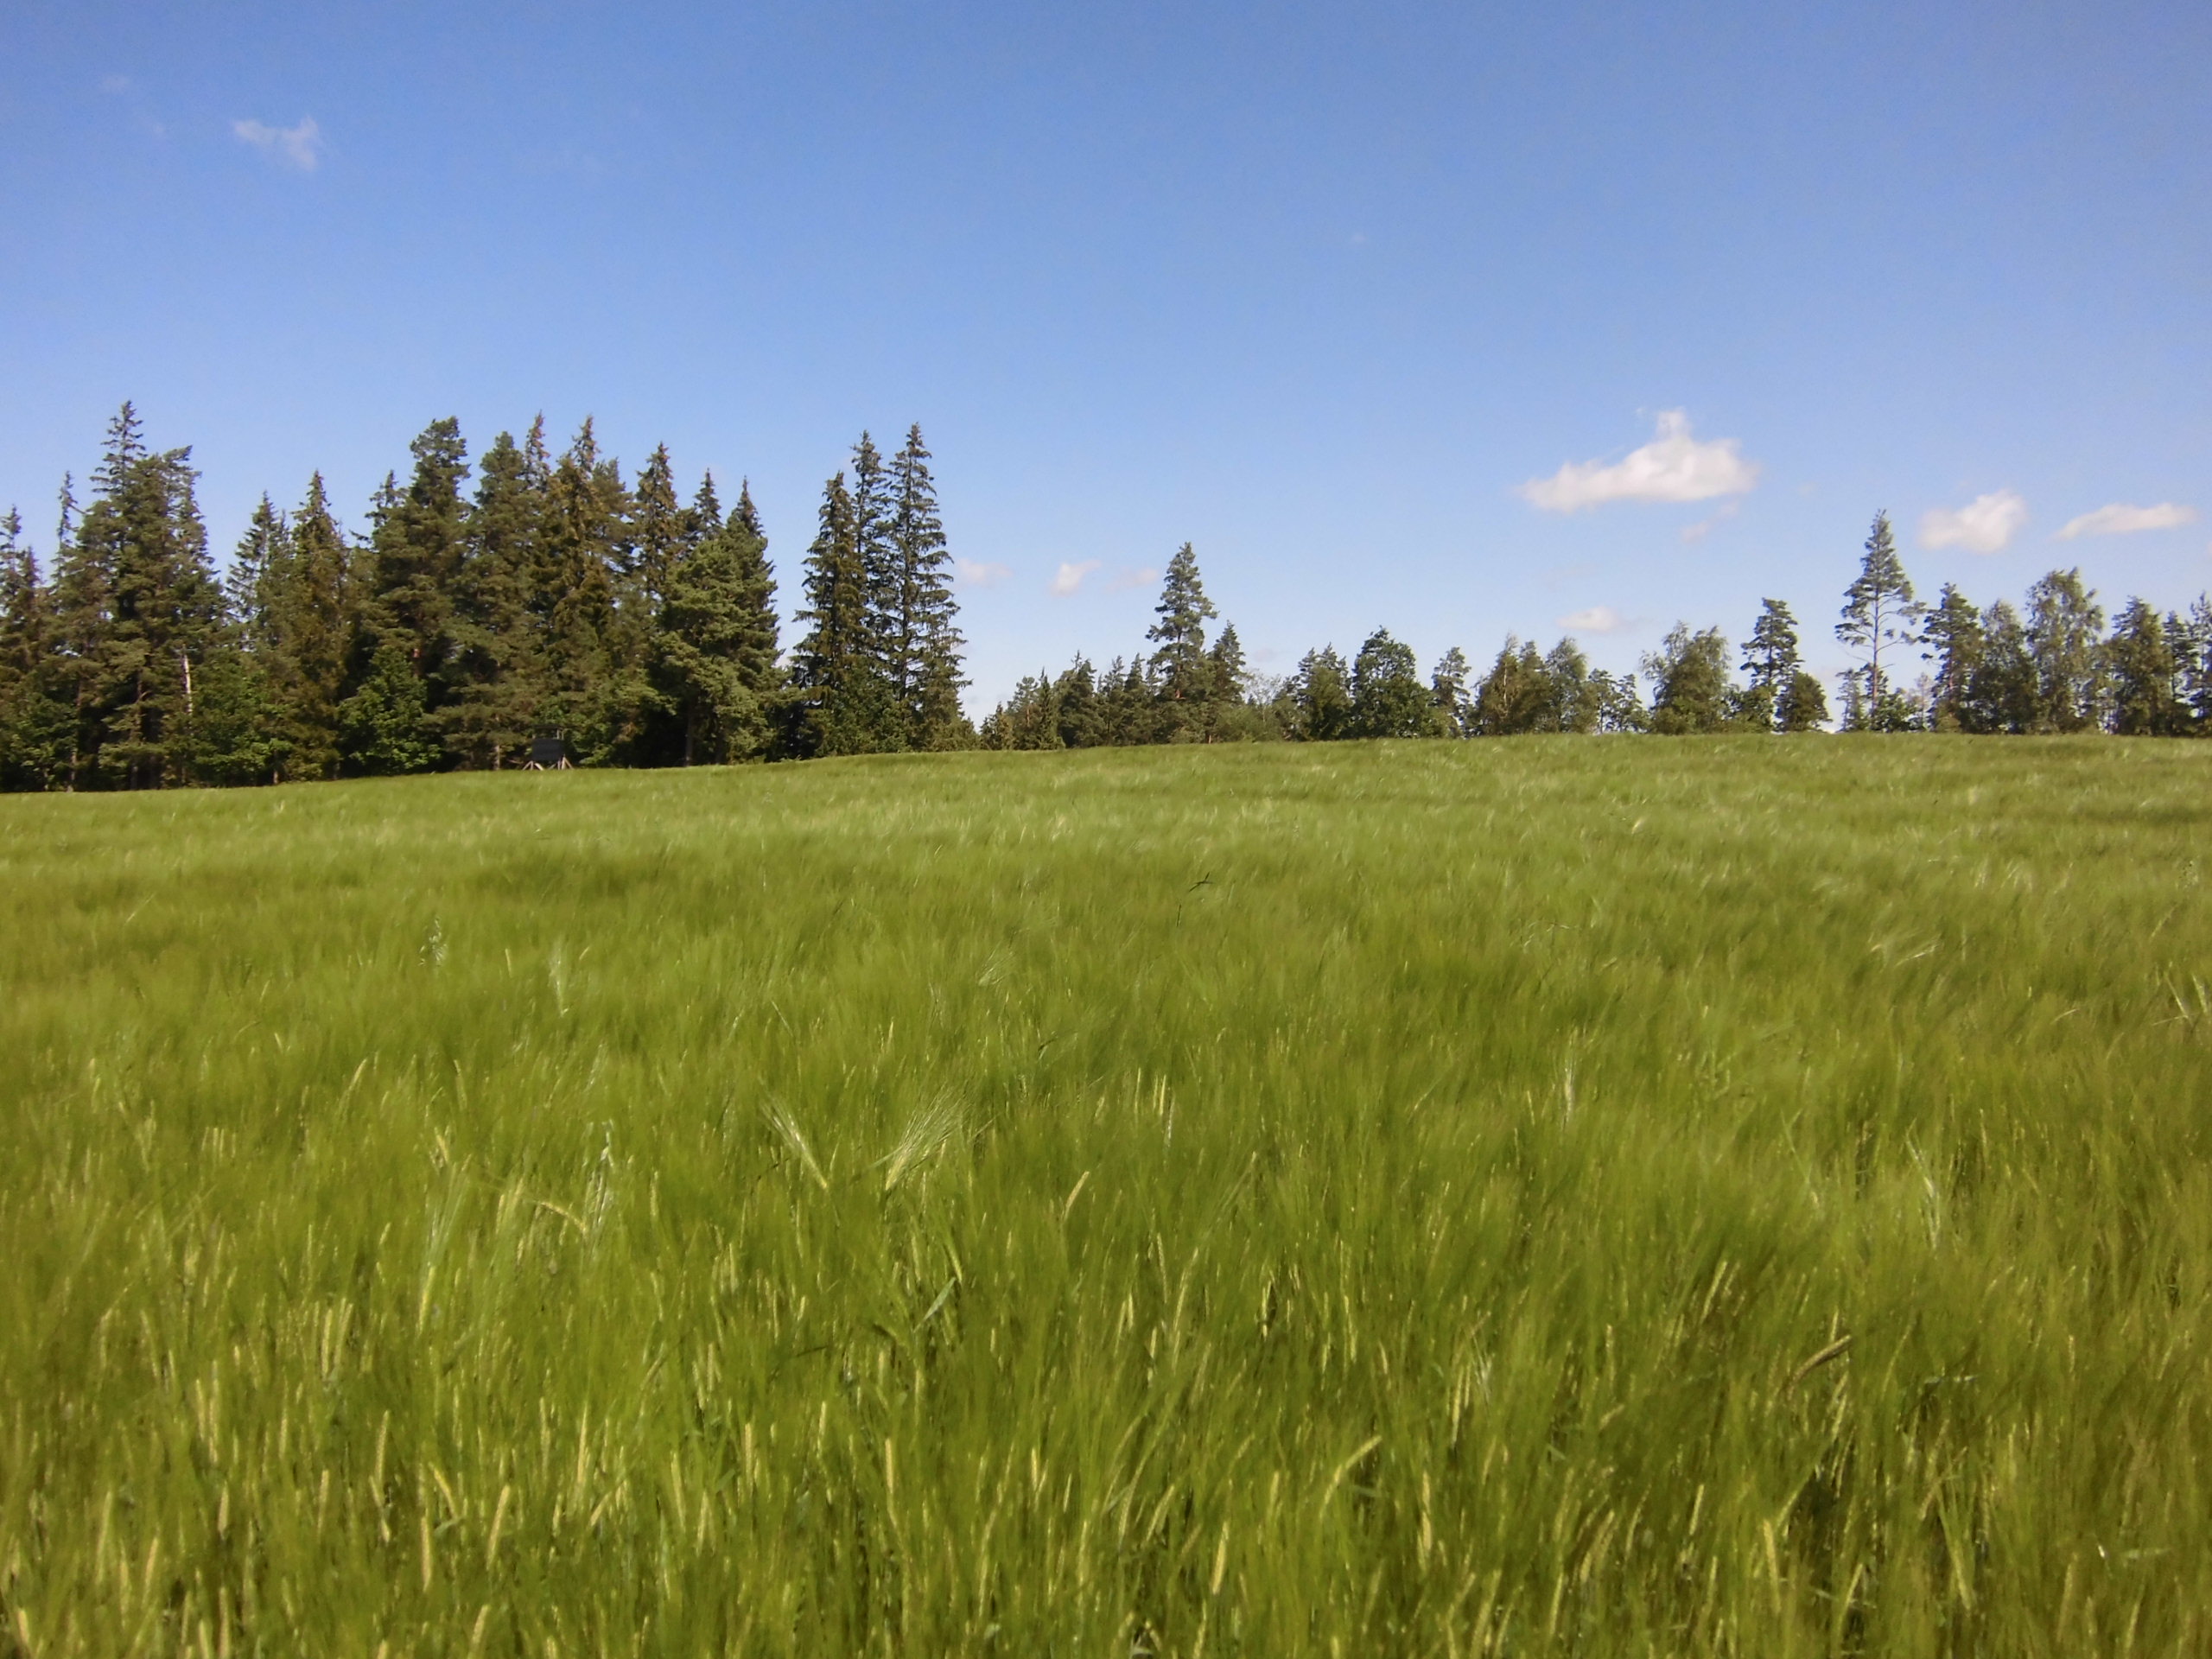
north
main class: Cropland
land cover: Barley
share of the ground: > 75 %
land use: Agriculture (excluding fallow land and kitchen gardens)
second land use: Amenities, museums, leisure
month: July
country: SE
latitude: 57.3221
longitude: 15.2943
